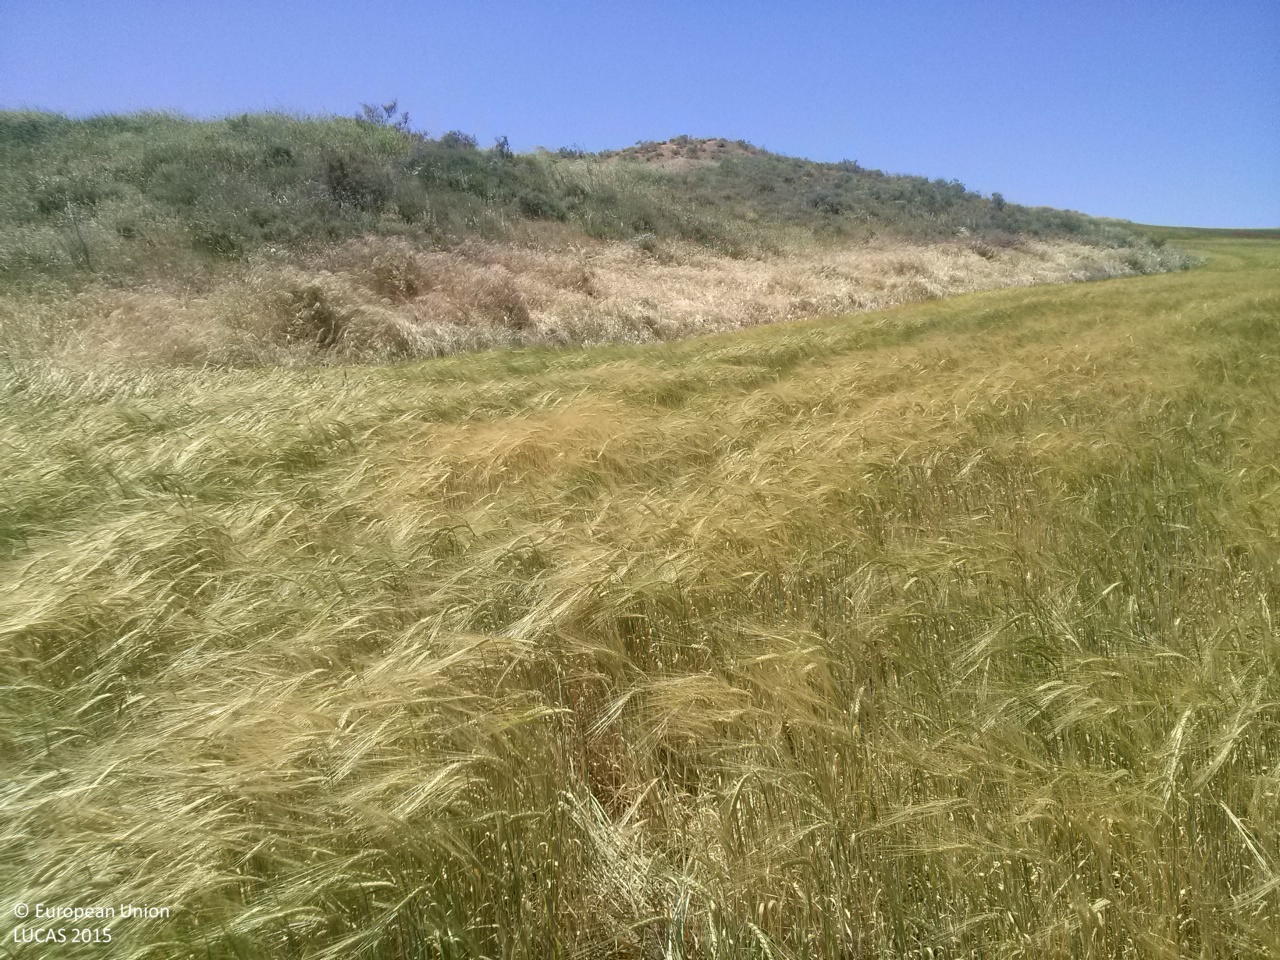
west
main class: Cropland
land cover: Barley
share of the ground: > 75 %
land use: Agriculture (excluding fallow land and kitchen gardens)
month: May
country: ES
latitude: 40.3282
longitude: -2.7481
